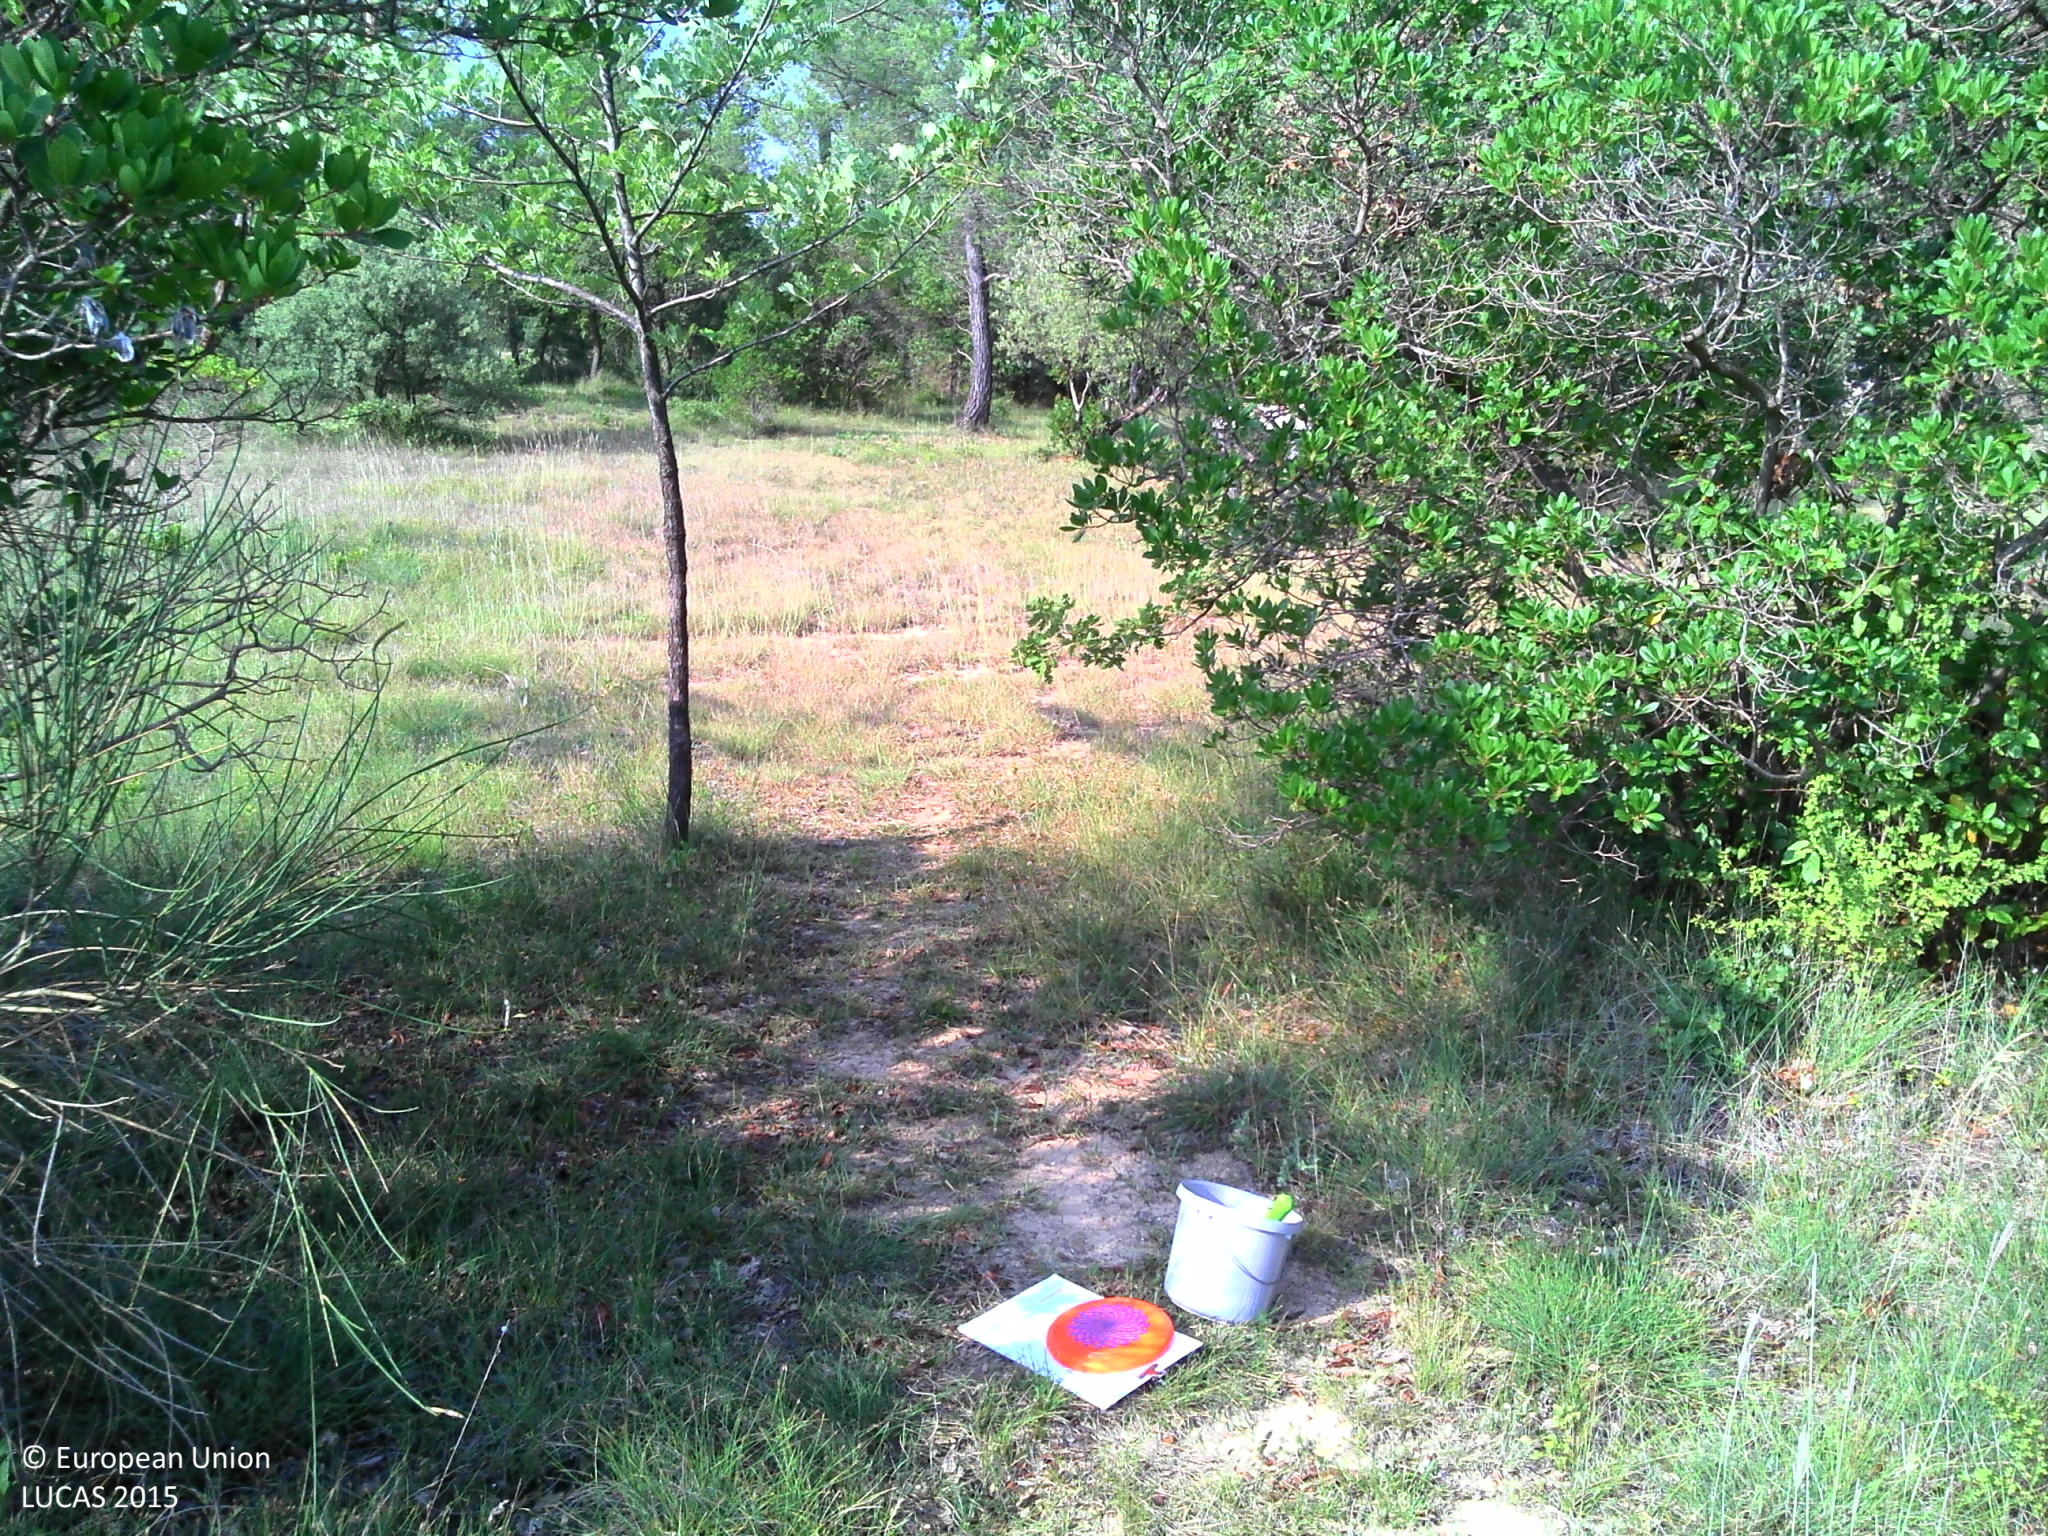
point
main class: Shrubland
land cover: Shrubland with sparse tree cover
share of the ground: > 75 %
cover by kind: shrubs 40 %, herbaceous plants 40 %, broadleaved forest trees 5 %, lichens and mosses 5 %, consolidated bare surface 5 %, unconsolidated bare surface 5 %
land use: Residential
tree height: < 5 m
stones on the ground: < 10 %
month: July
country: FR
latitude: 43.7695
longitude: 5.5987
